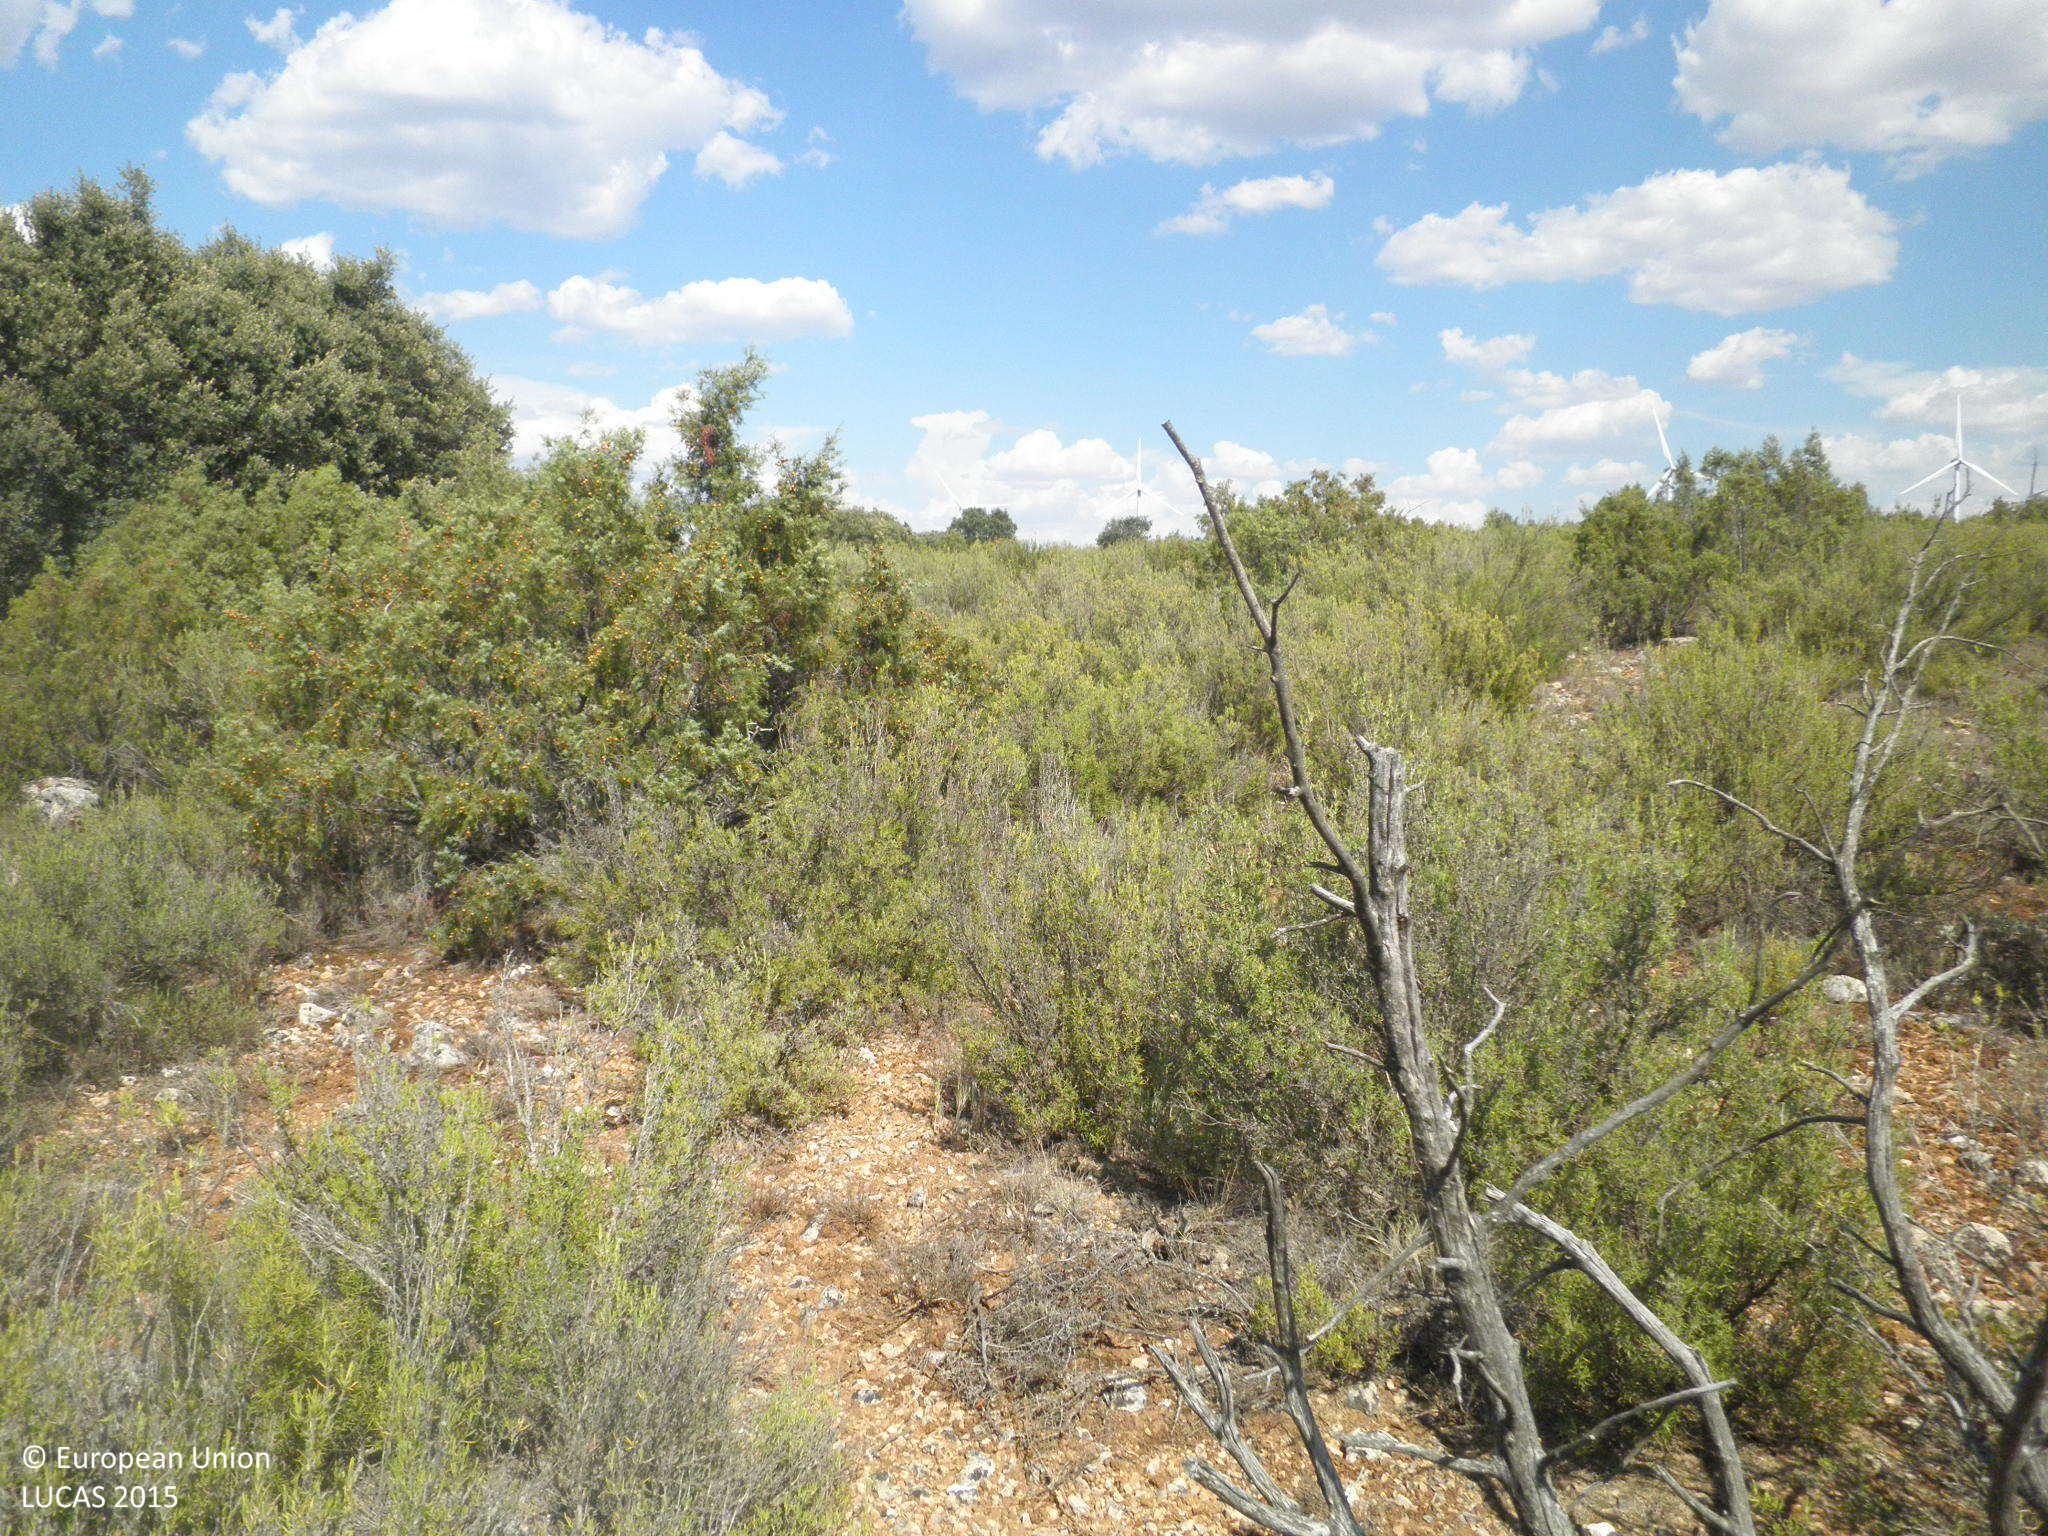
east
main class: Shrubland
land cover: Shrubland with sparse tree cover
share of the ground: 25 - 50 %
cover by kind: shrubs 40 %, unconsolidated bare surface 40 %, consolidated bare surface 10 %, broadleaved forest trees 5 %, herbaceous plants 5 %
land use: Semi-natural and natural areas not in use
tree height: < 5 m
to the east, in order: Shrubland with sparse tree cover; Shrubland without tree cover; Shrubland with sparse tree cover
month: July
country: ES
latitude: 39.6424
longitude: -1.8122
